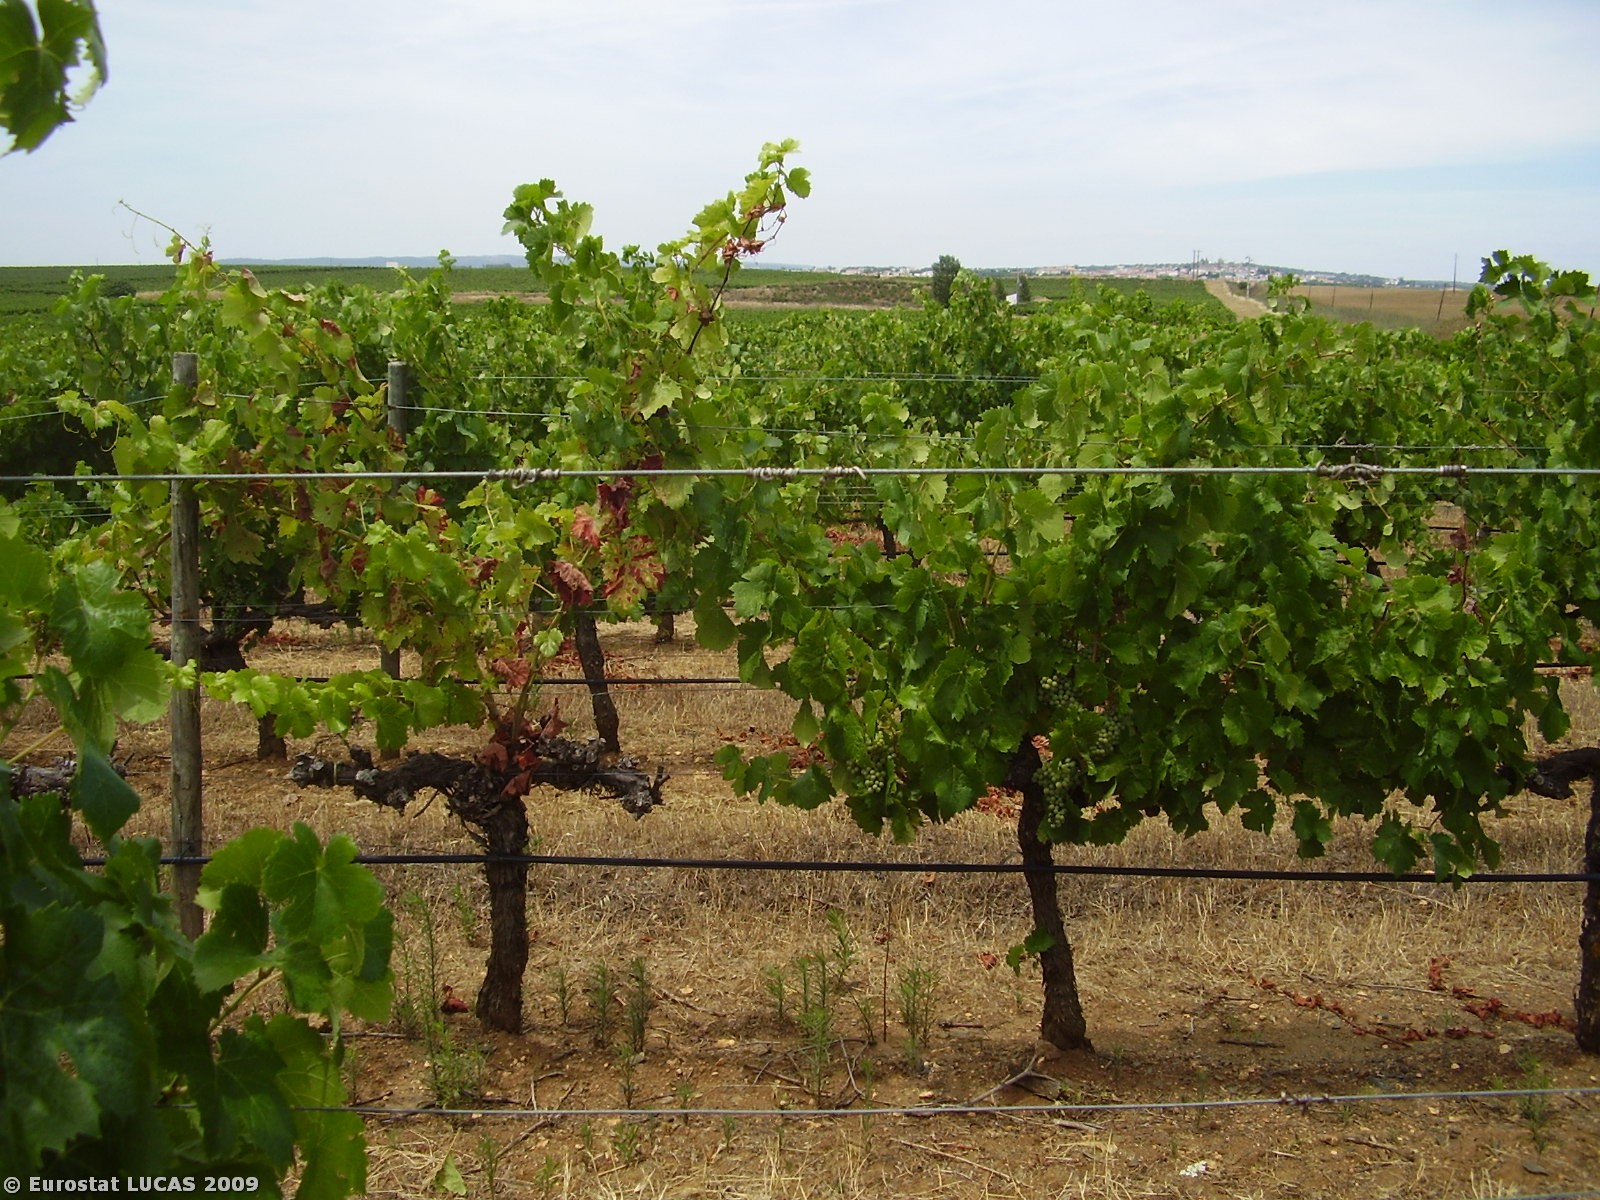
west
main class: Cropland
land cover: Vineyards
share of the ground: 10 - 25 %
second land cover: Spontaneously vegetated surfaces
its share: 50 - 75 %
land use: Agriculture (excluding fallow land and kitchen gardens)
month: July
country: PT
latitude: 38.5581
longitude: -7.8597
